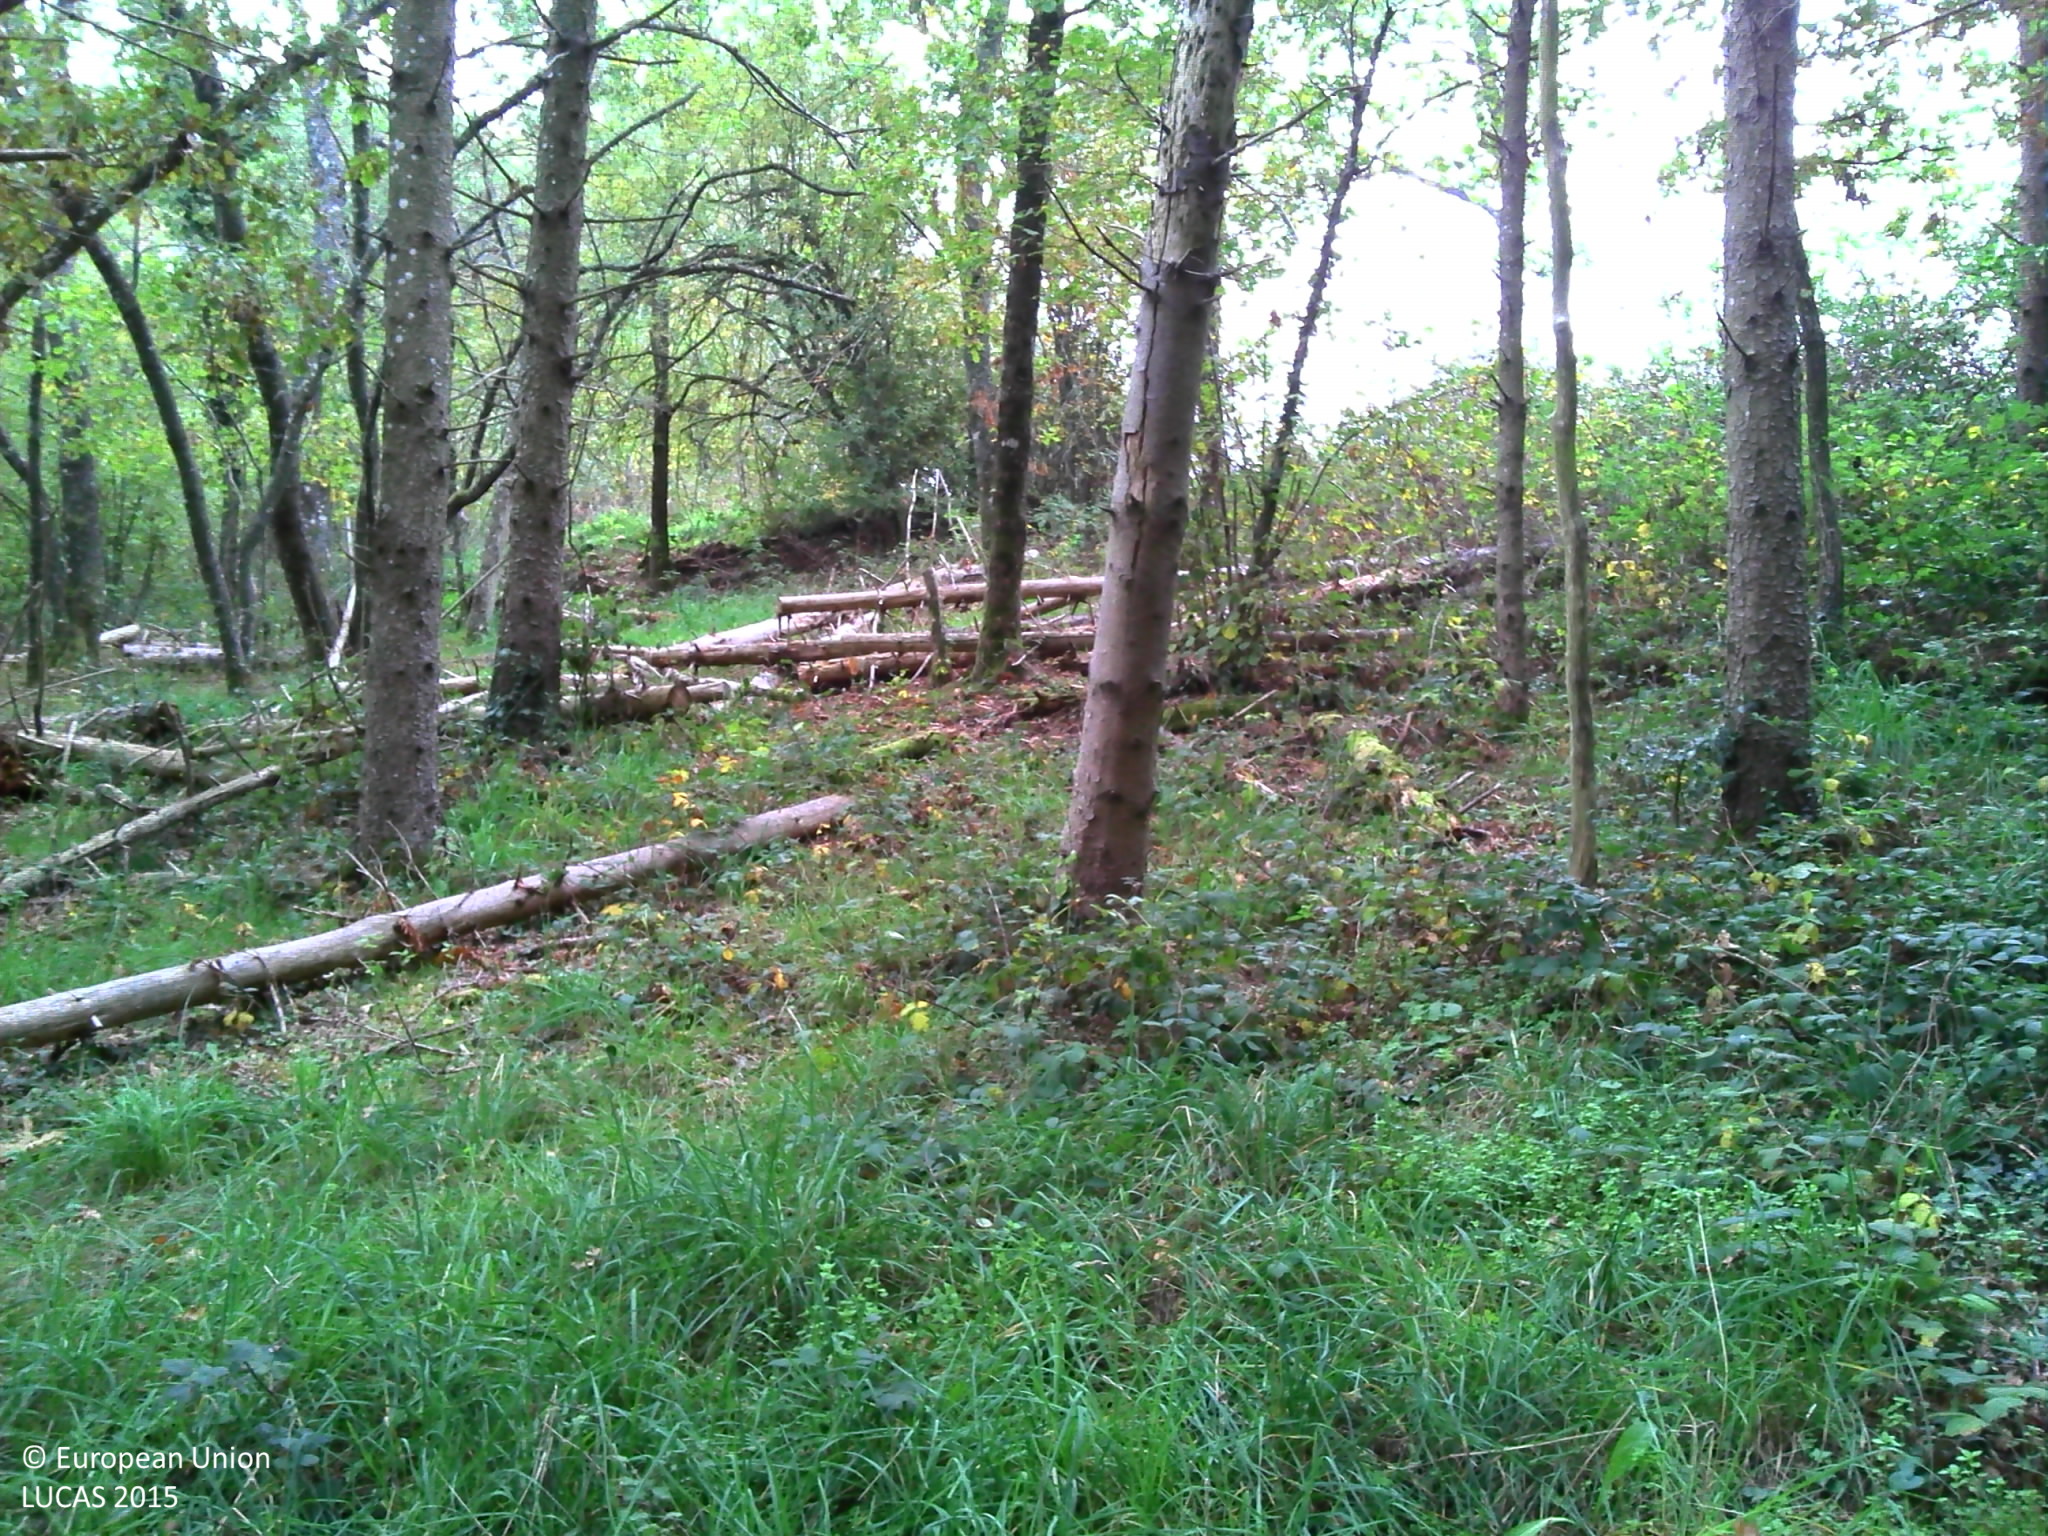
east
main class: Woodland
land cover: Spruce dominated coniferous woodland
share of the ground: > 75 %
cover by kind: coniferous forest trees 85 %, herbaceous plants 10 %, broadleaved forest trees 5 %
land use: Forestry
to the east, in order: Spruce dominated coniferous woodland; Grassland without tree/shrub cover; Broadleaved woodland; Grassland without tree/shrub cover
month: October
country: FR
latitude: 46.0140
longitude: 3.0113
